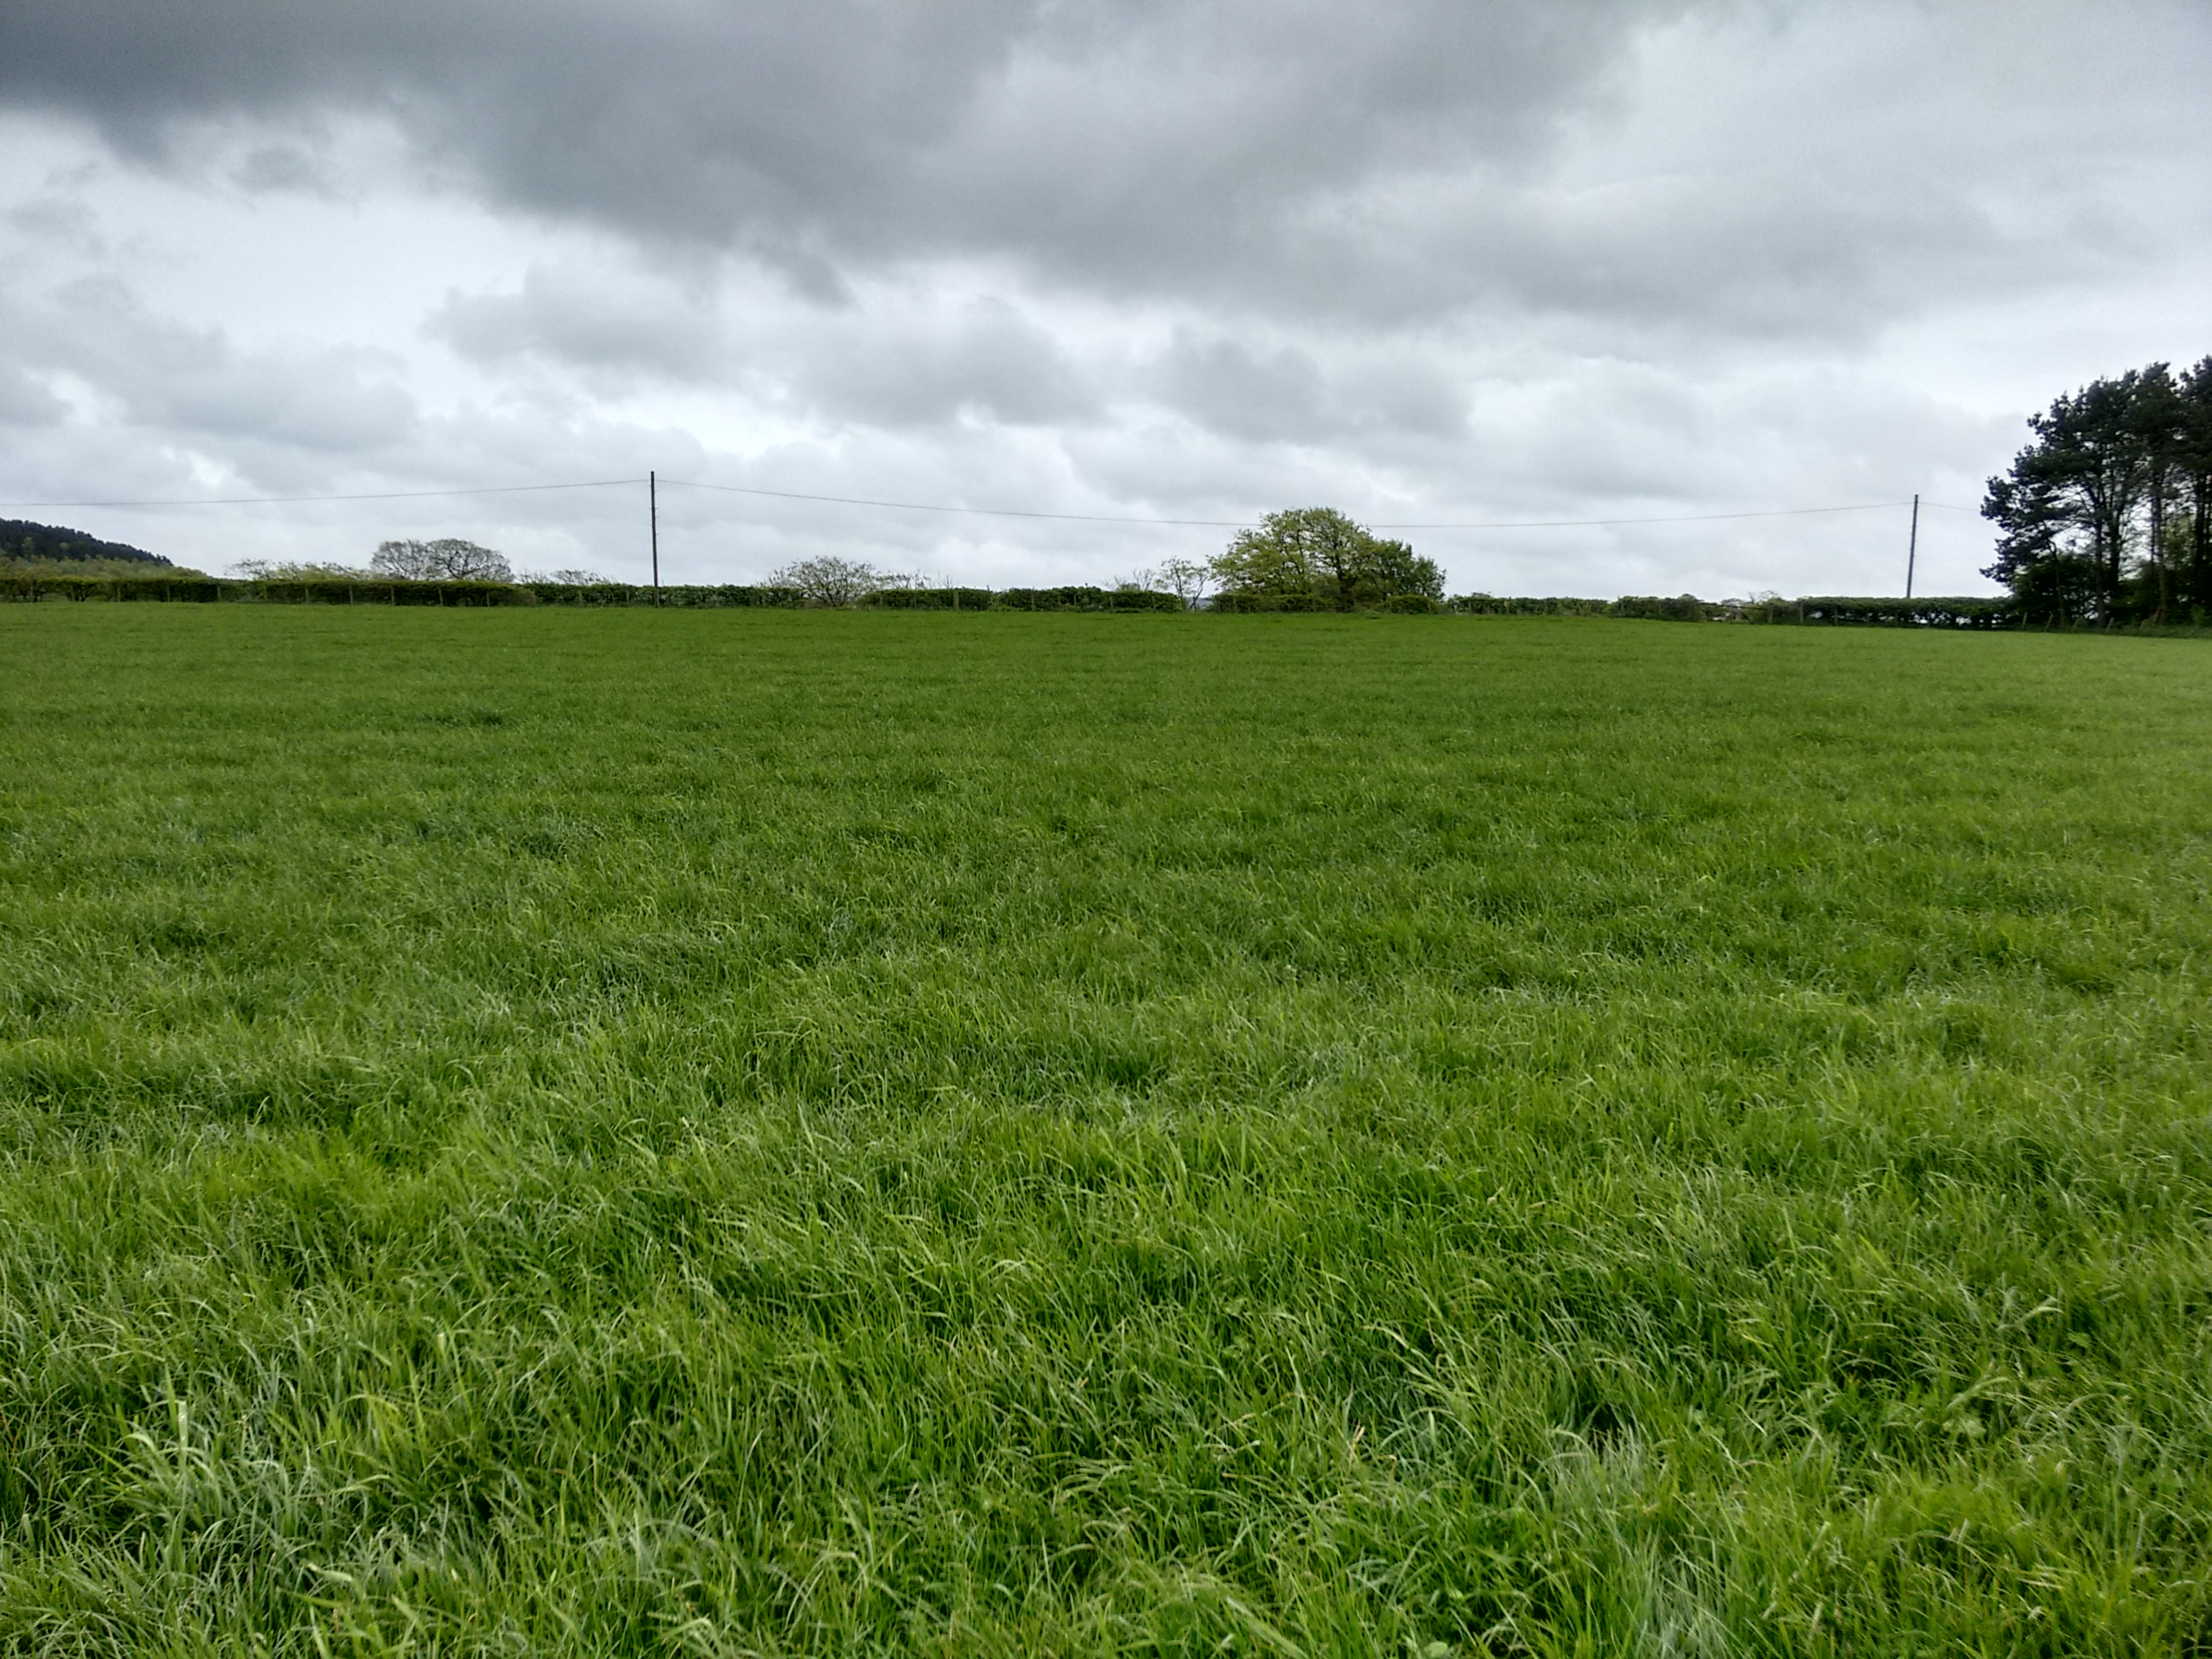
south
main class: Grassland
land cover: Grassland without tree/shrub cover
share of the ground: > 75 %
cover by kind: herbaceous plants 100 %
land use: Agriculture (excluding fallow land and kitchen gardens)
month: May
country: GB
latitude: 55.8562
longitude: -3.6437
